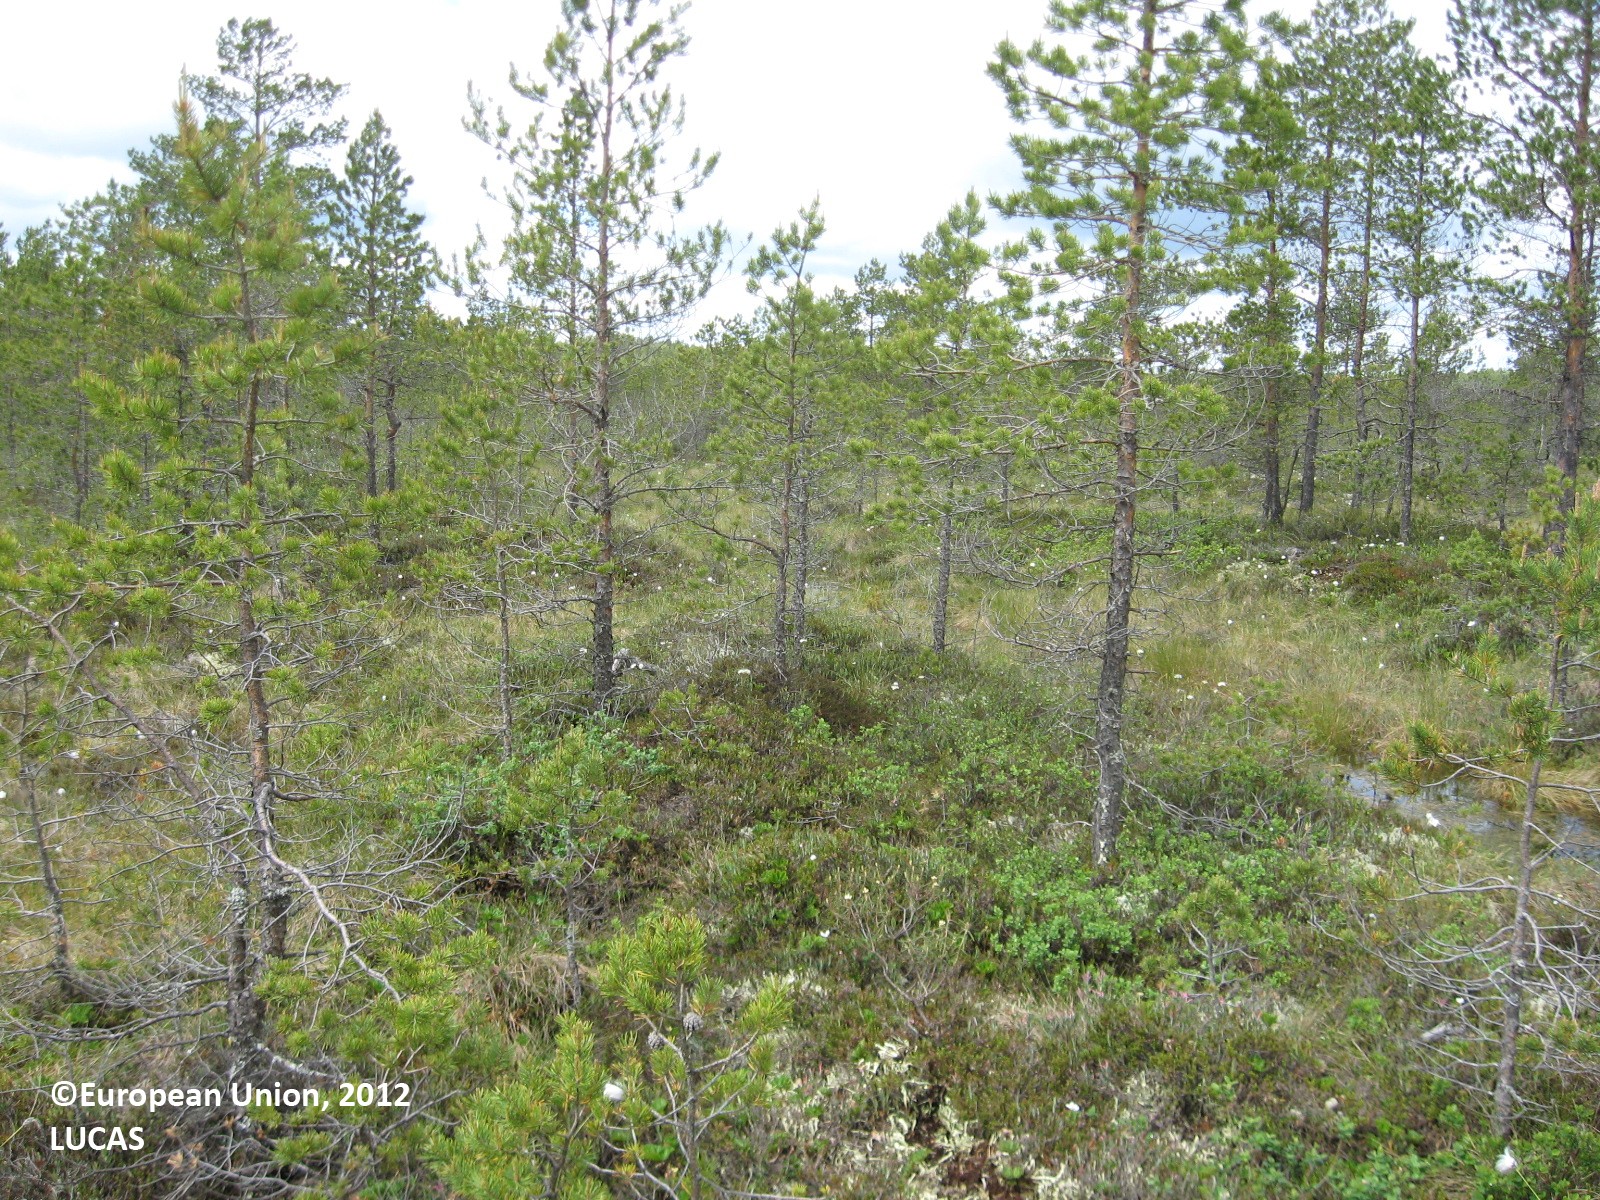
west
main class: Woodland
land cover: Pine dominated coniferous woodland
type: mire and swamp forests
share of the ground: 25 - 50 %
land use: Forestry
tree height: > 5 m
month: June
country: FI
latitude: 63.0997
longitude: 22.6729
